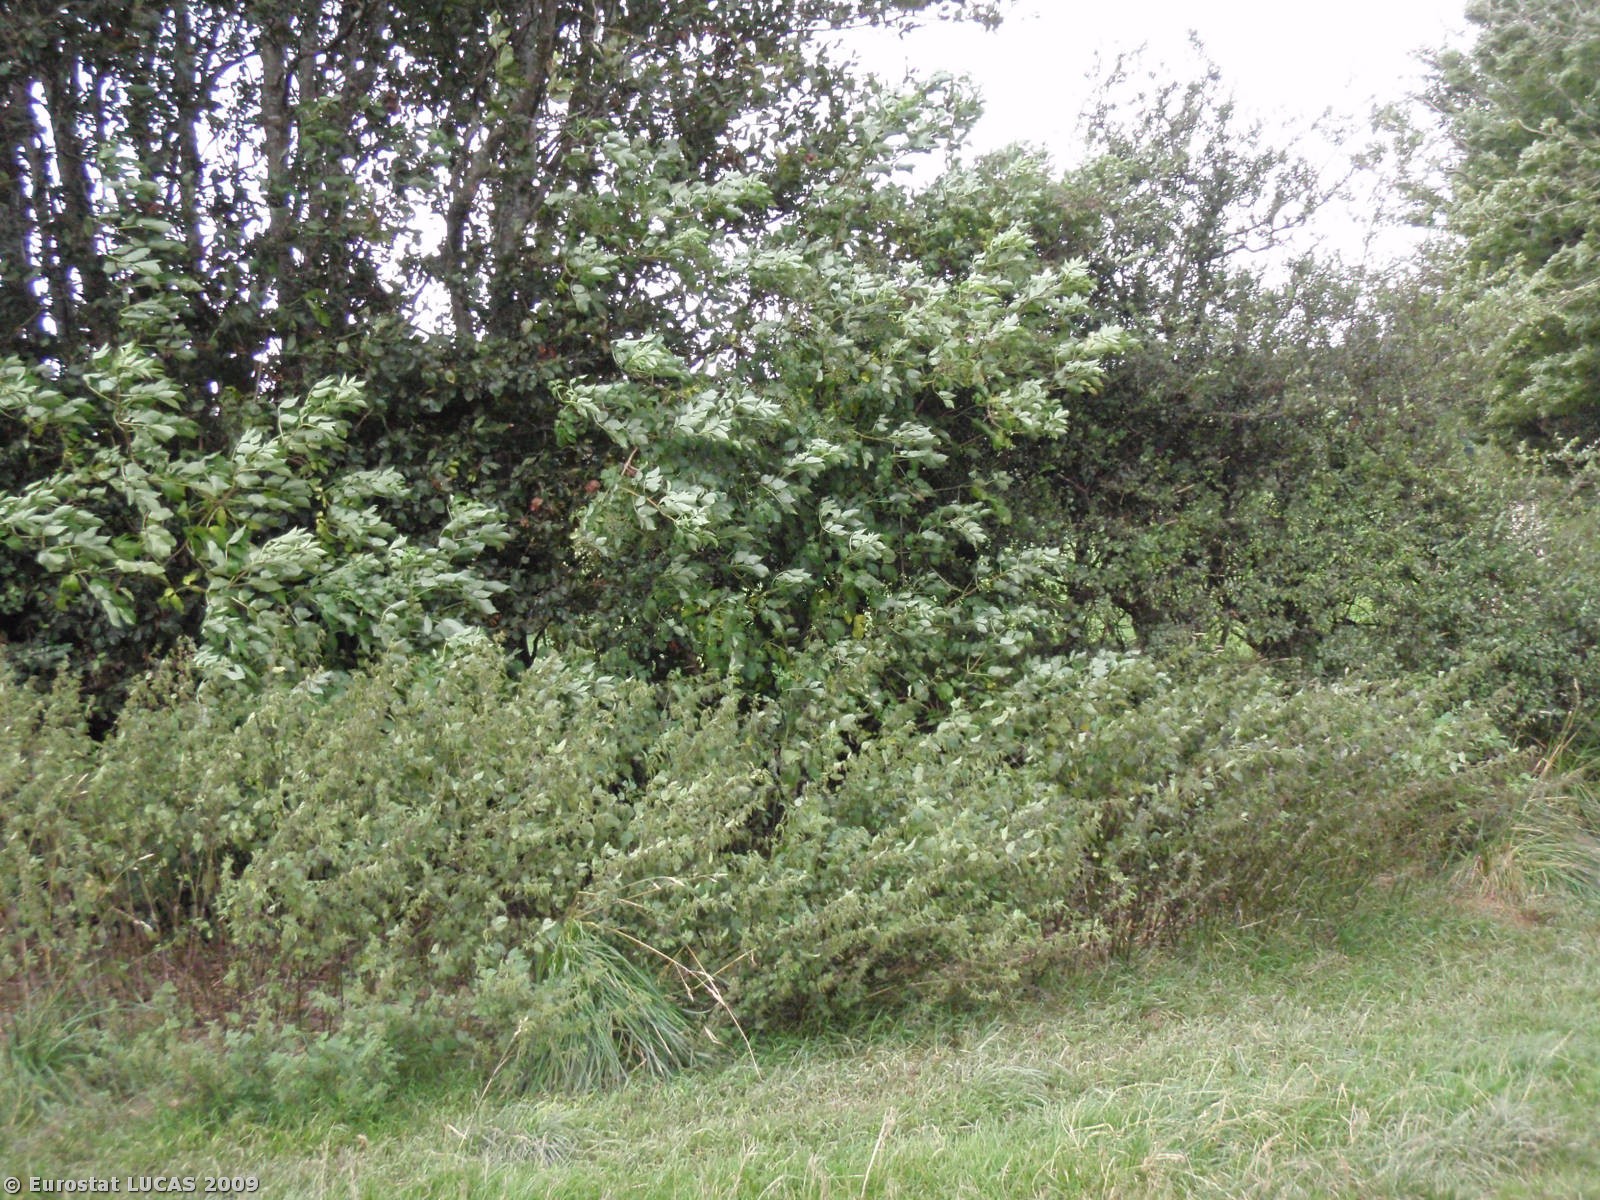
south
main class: Grassland
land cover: Grassland without tree/shrub cover
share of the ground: 50 - 75 %
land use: Agriculture (excluding fallow land and kitchen gardens)
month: September
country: GB
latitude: 51.1162
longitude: -3.4401
